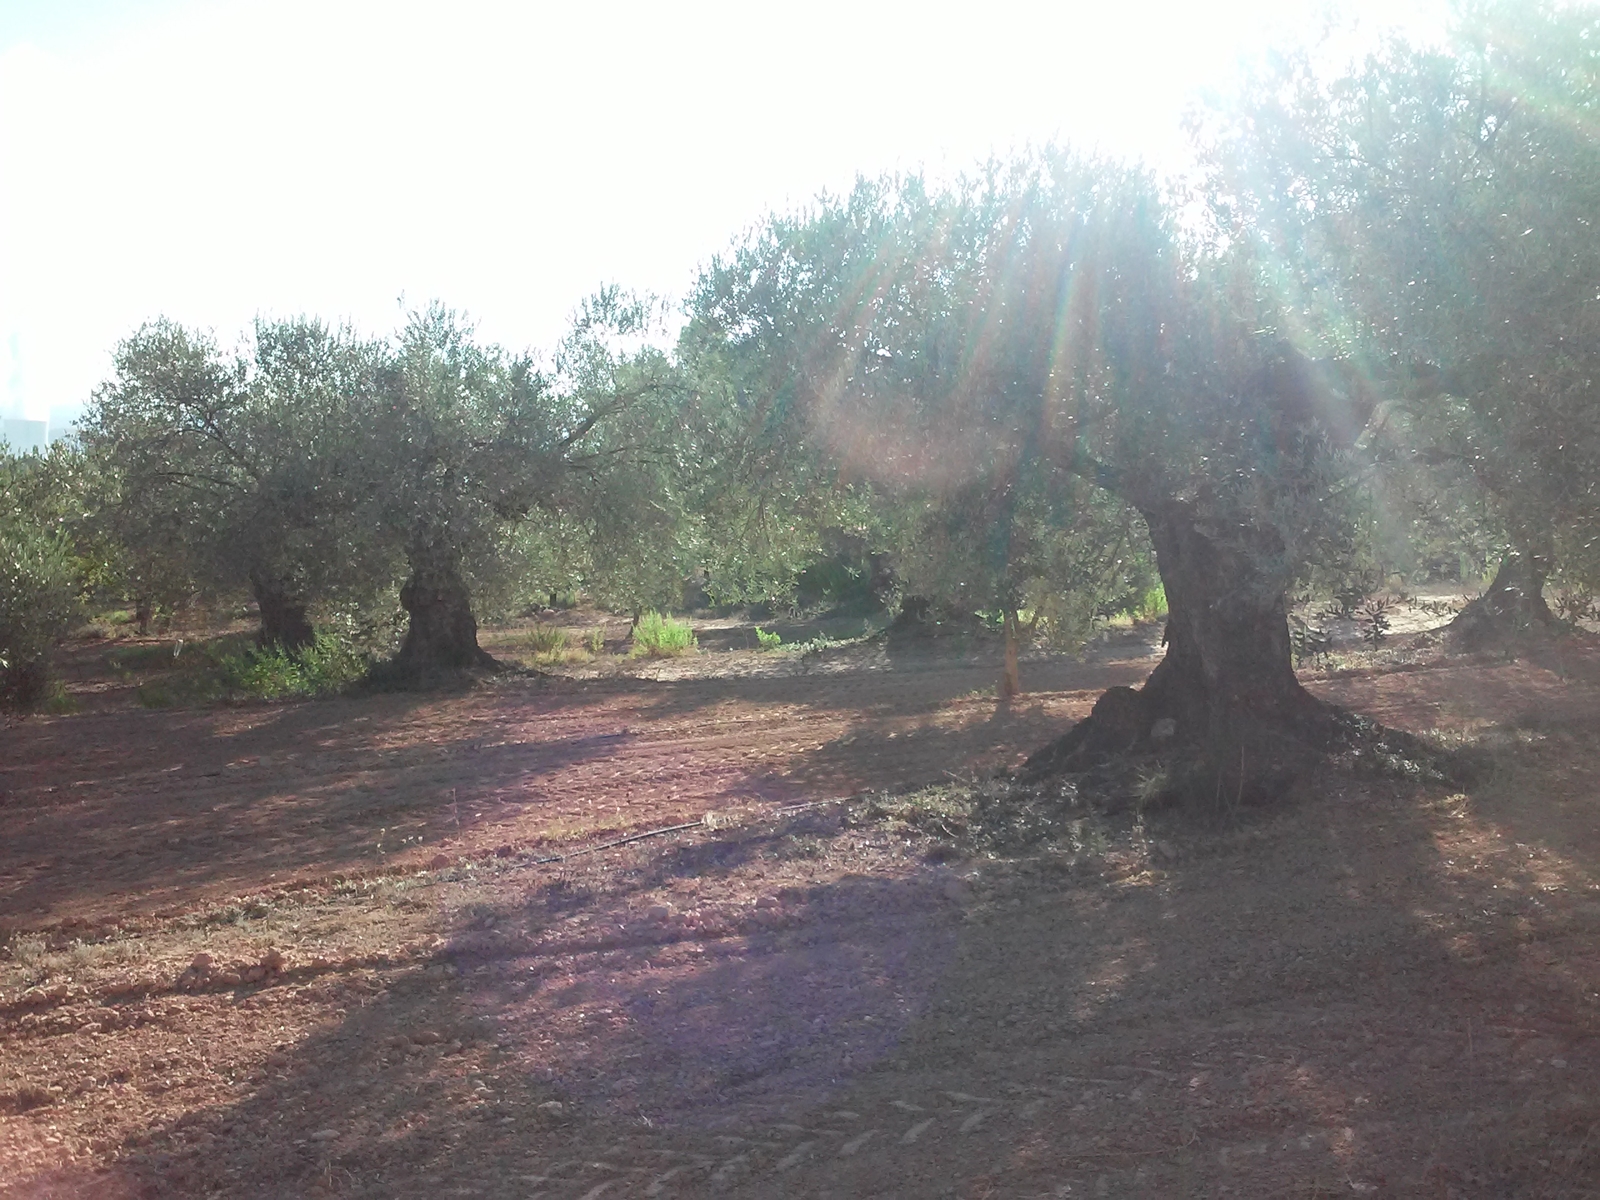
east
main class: Cropland
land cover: Olive groves
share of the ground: 25 - 50 %
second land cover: Other bare soil
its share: > 75 %
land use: Agriculture (excluding fallow land and kitchen gardens)
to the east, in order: Olive groves; Other bare soil; Nuts trees; Pine dominated coniferous woodland; Shrubland with sparse tree cover; Grassland without tree/shrub cover; Pine dominated coniferous woodland; Shrubland with sparse tree cover; Pine dominated coniferous woodland
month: September
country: ES
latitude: 41.1919
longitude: 0.5357
